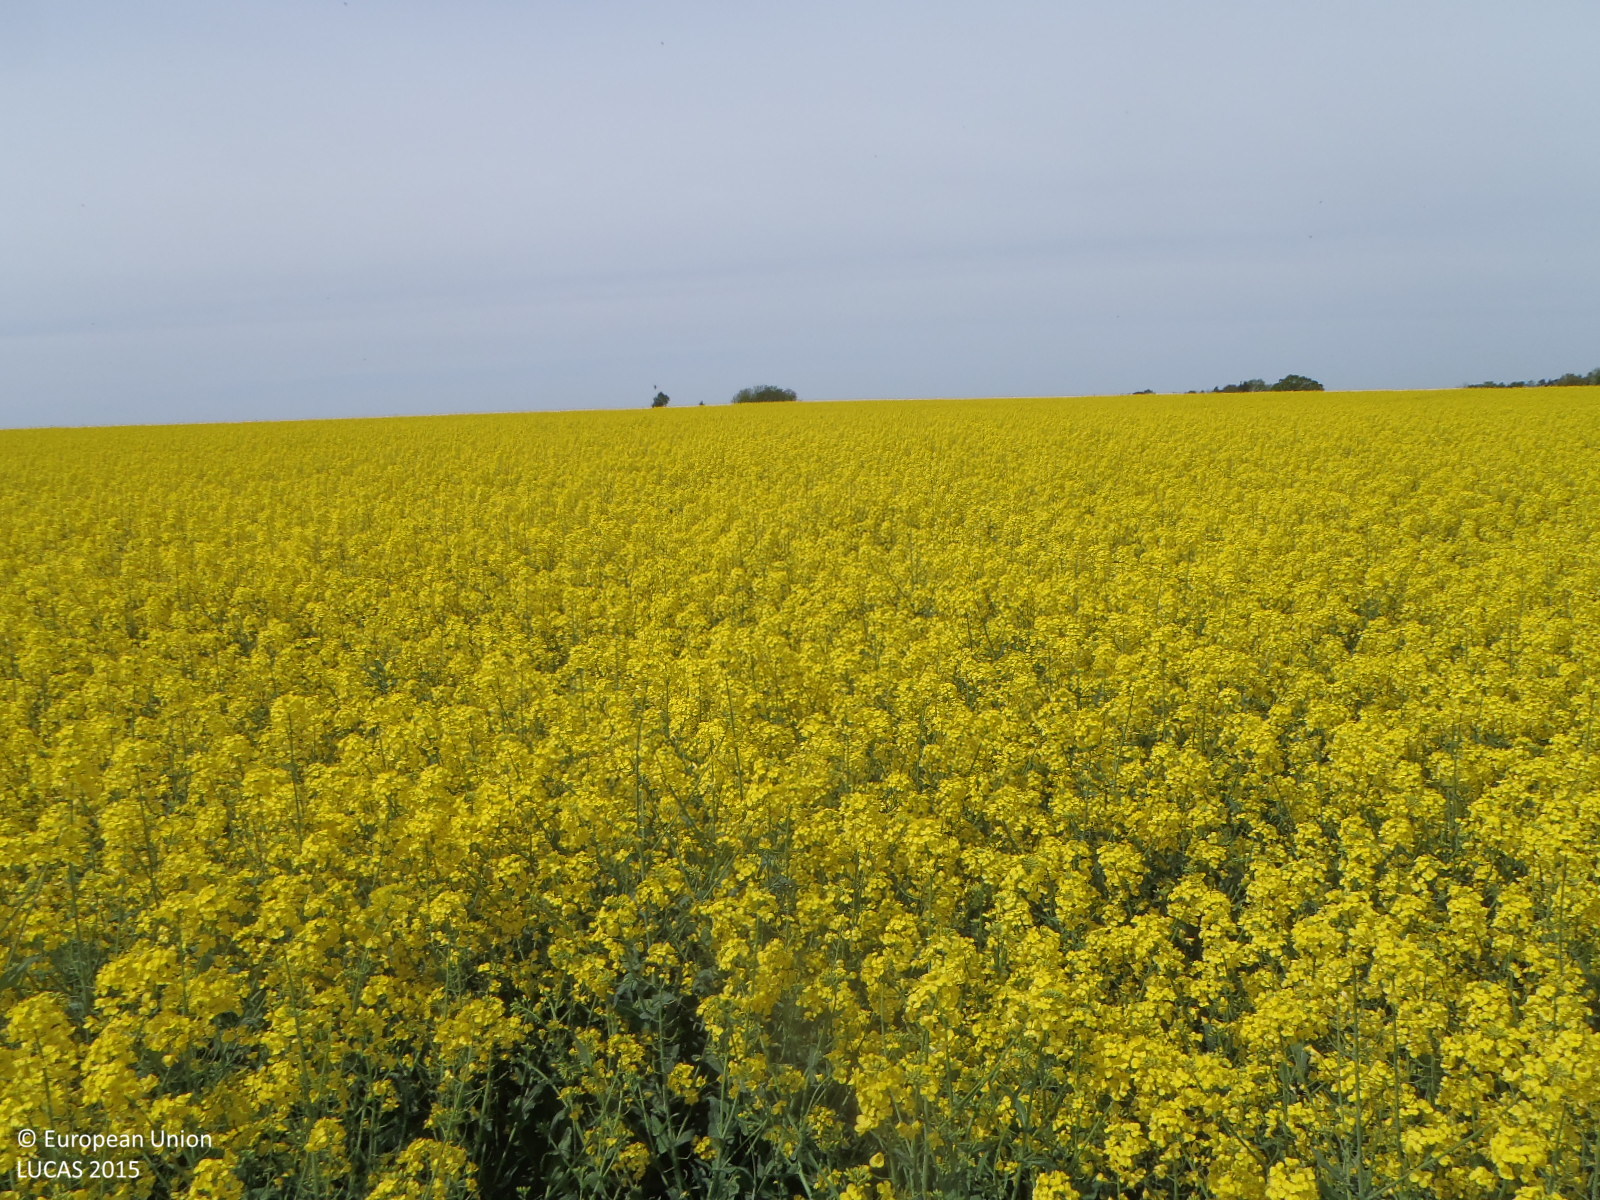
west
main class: Cropland
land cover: Rape and turnip rape
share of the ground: > 75 %
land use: Agriculture (excluding fallow land and kitchen gardens)
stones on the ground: < 10 %
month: May
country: CZ
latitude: 49.1960
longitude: 14.9011
